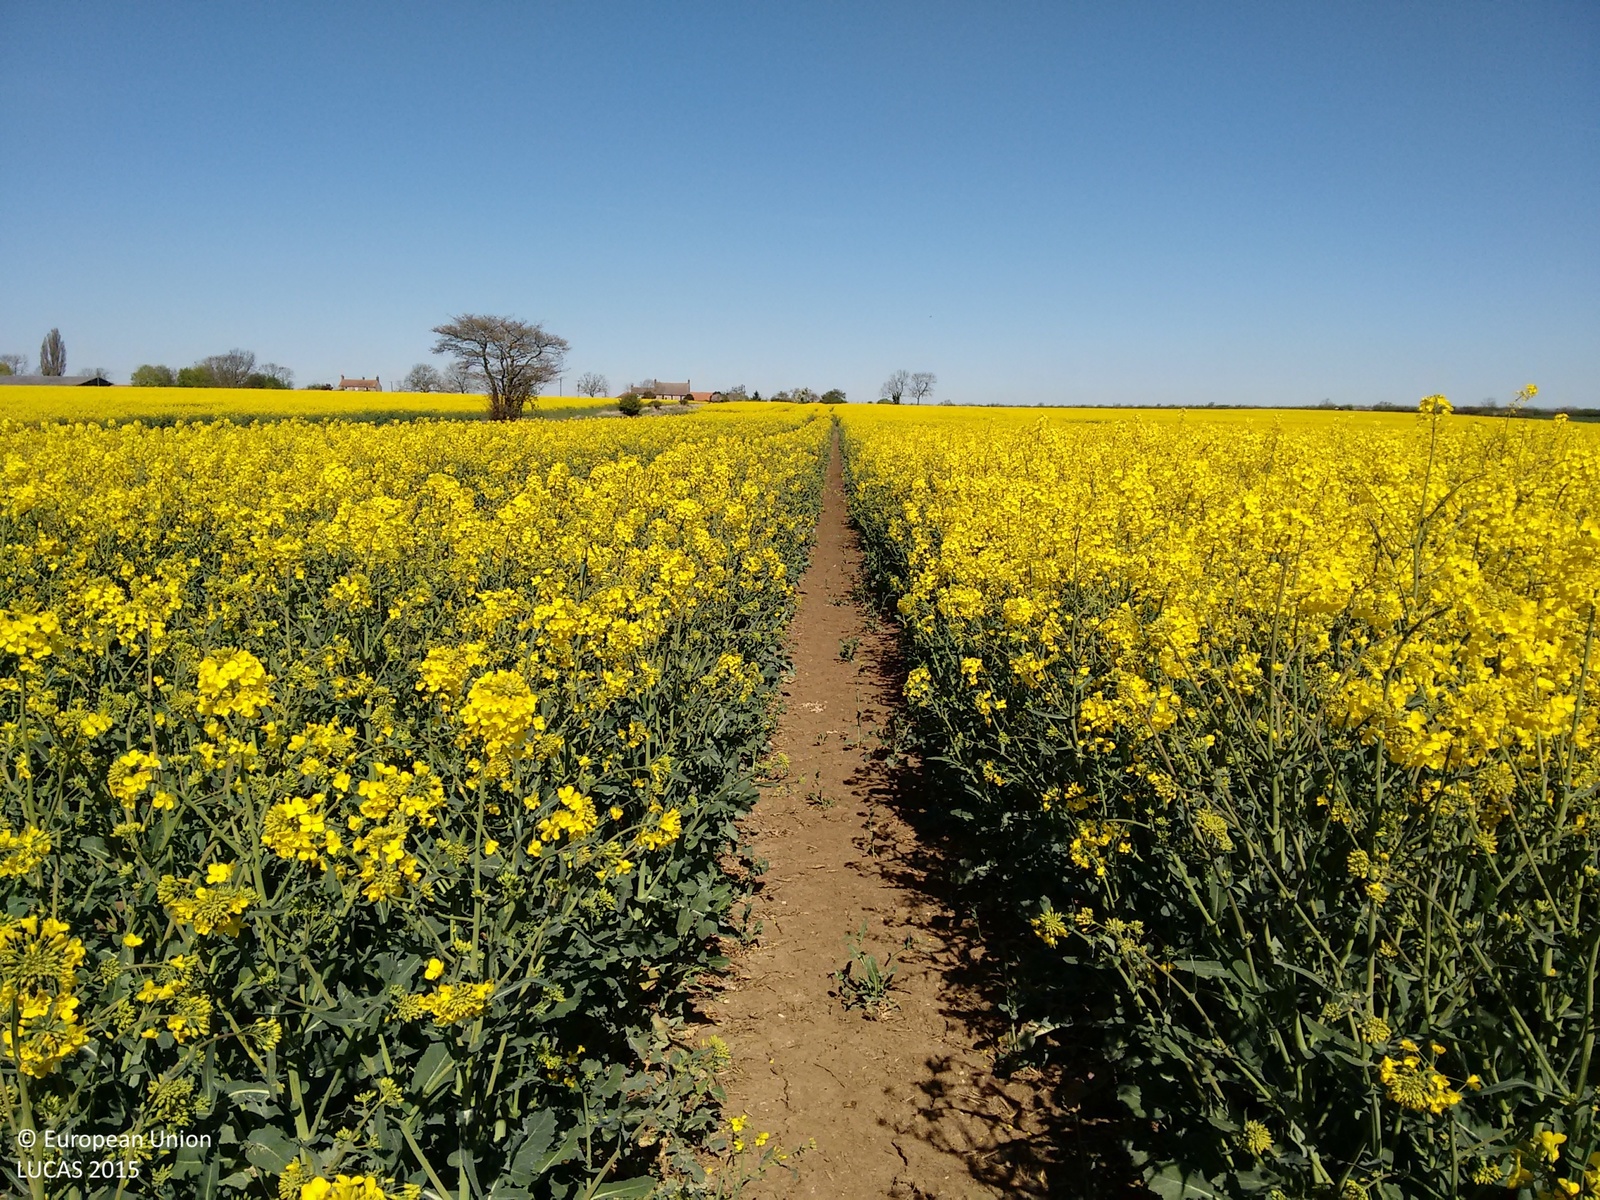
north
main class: Cropland
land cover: Rape and turnip rape
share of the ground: > 75 %
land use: Agriculture (excluding fallow land and kitchen gardens)
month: April
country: GB
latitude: 53.3525
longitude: -0.6000
